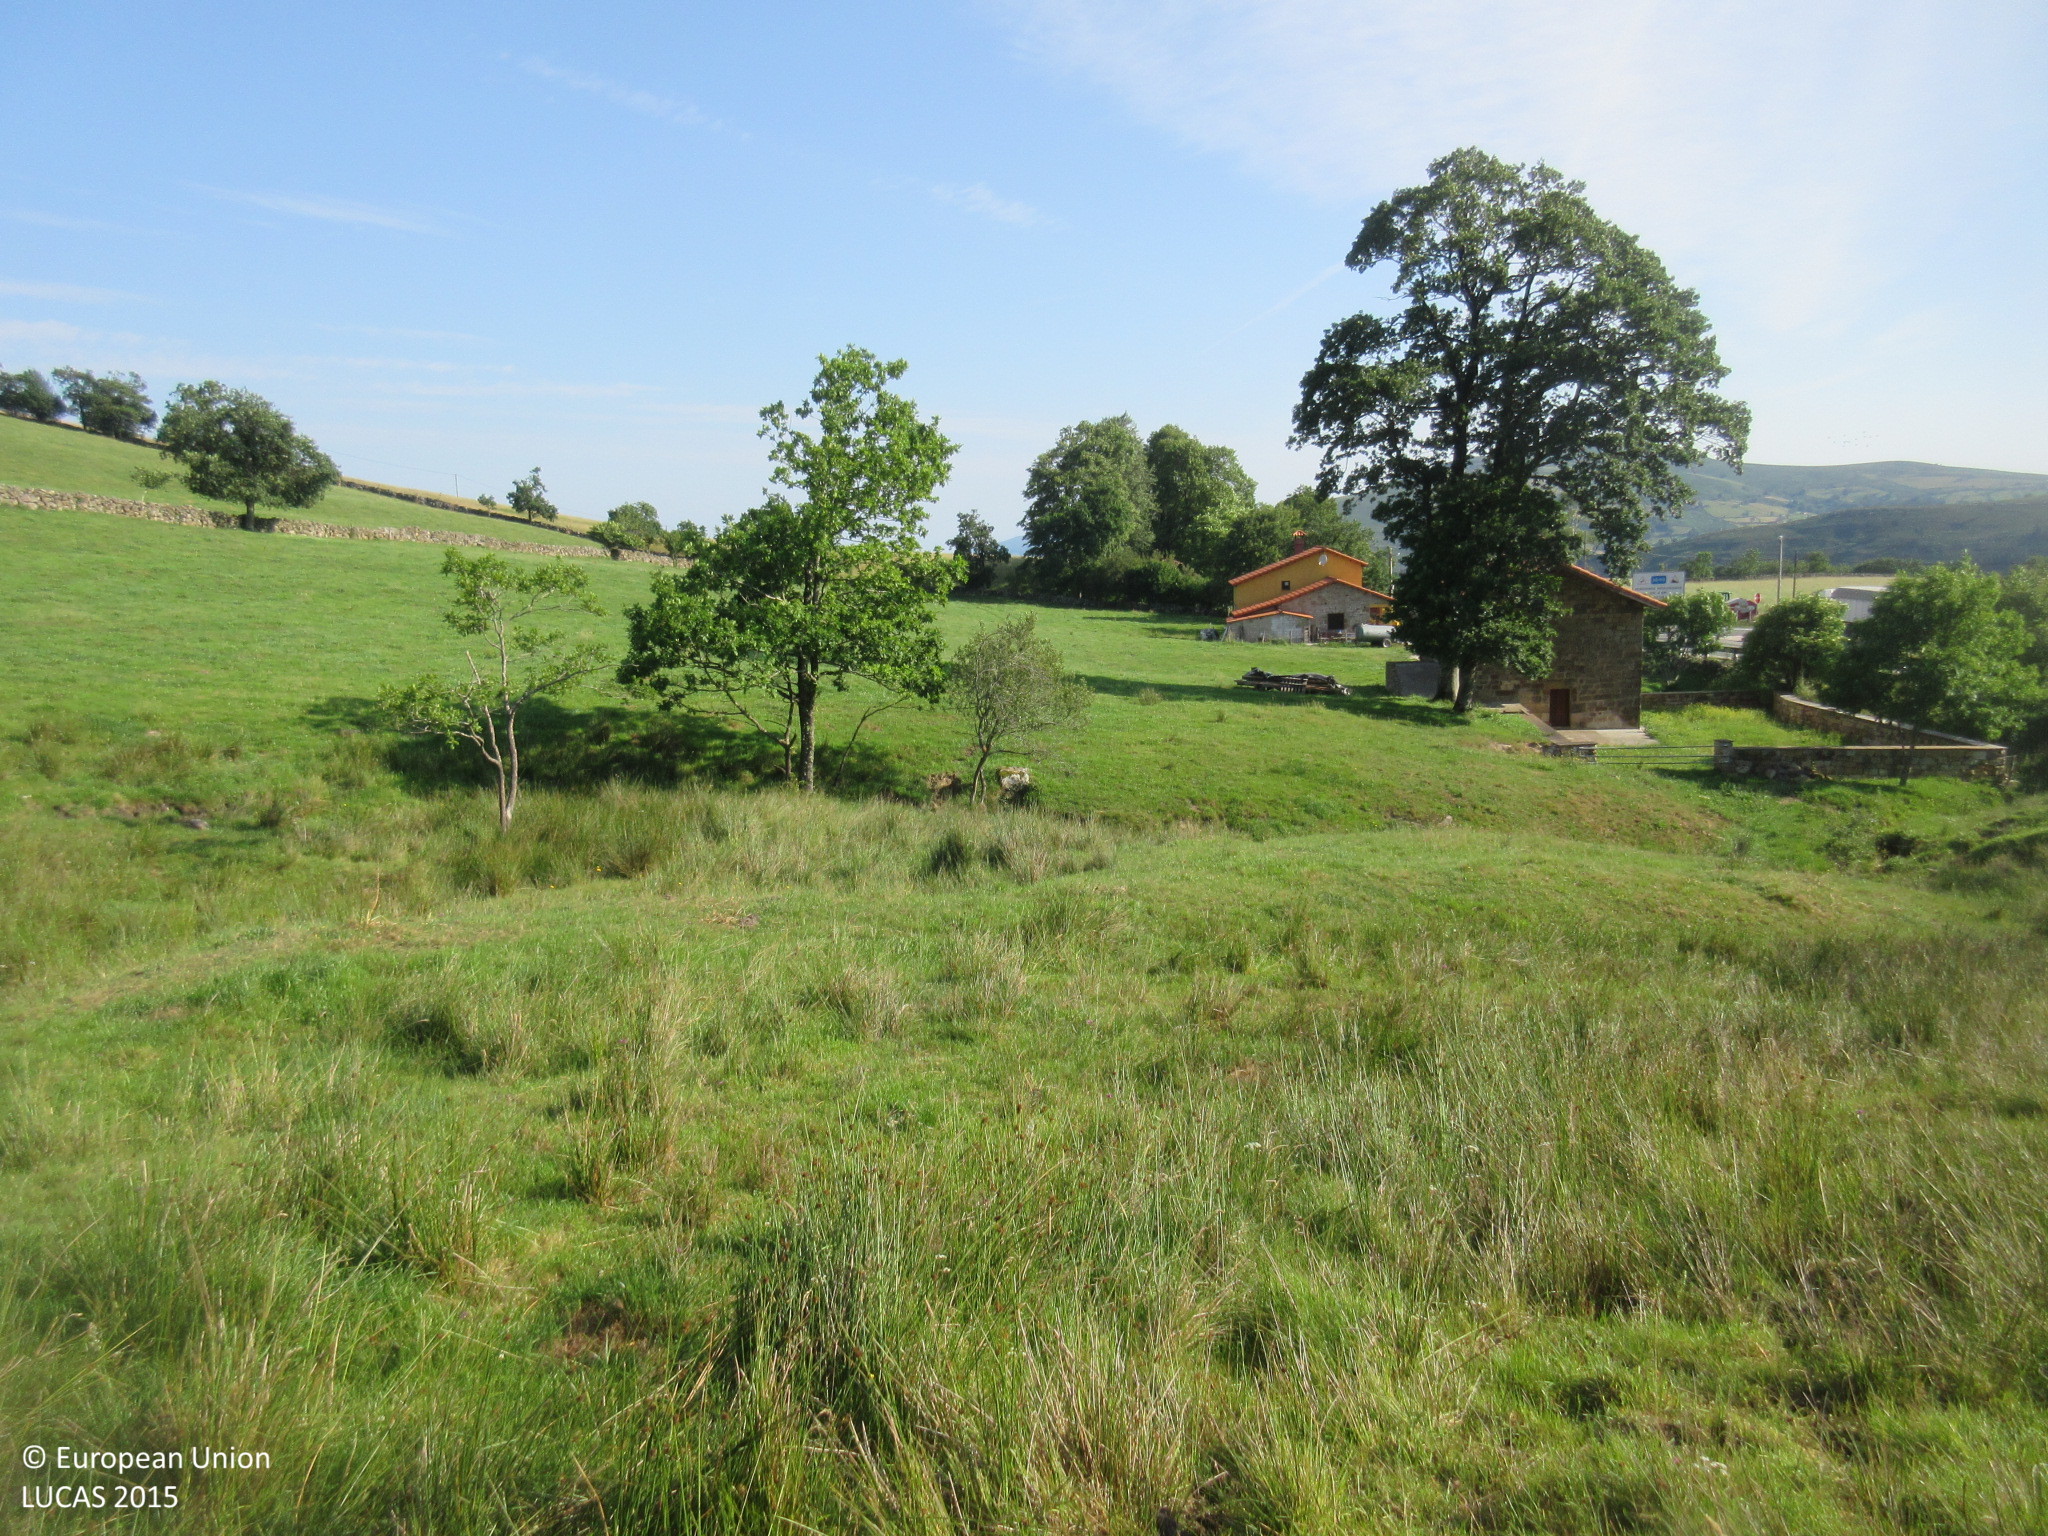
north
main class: Grassland
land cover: Grassland without tree/shrub cover
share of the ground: > 75 %
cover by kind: herbaceous plants 100 %
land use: Agriculture (excluding fallow land and kitchen gardens)
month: July
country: ES
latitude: 43.0643
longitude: -3.8856
